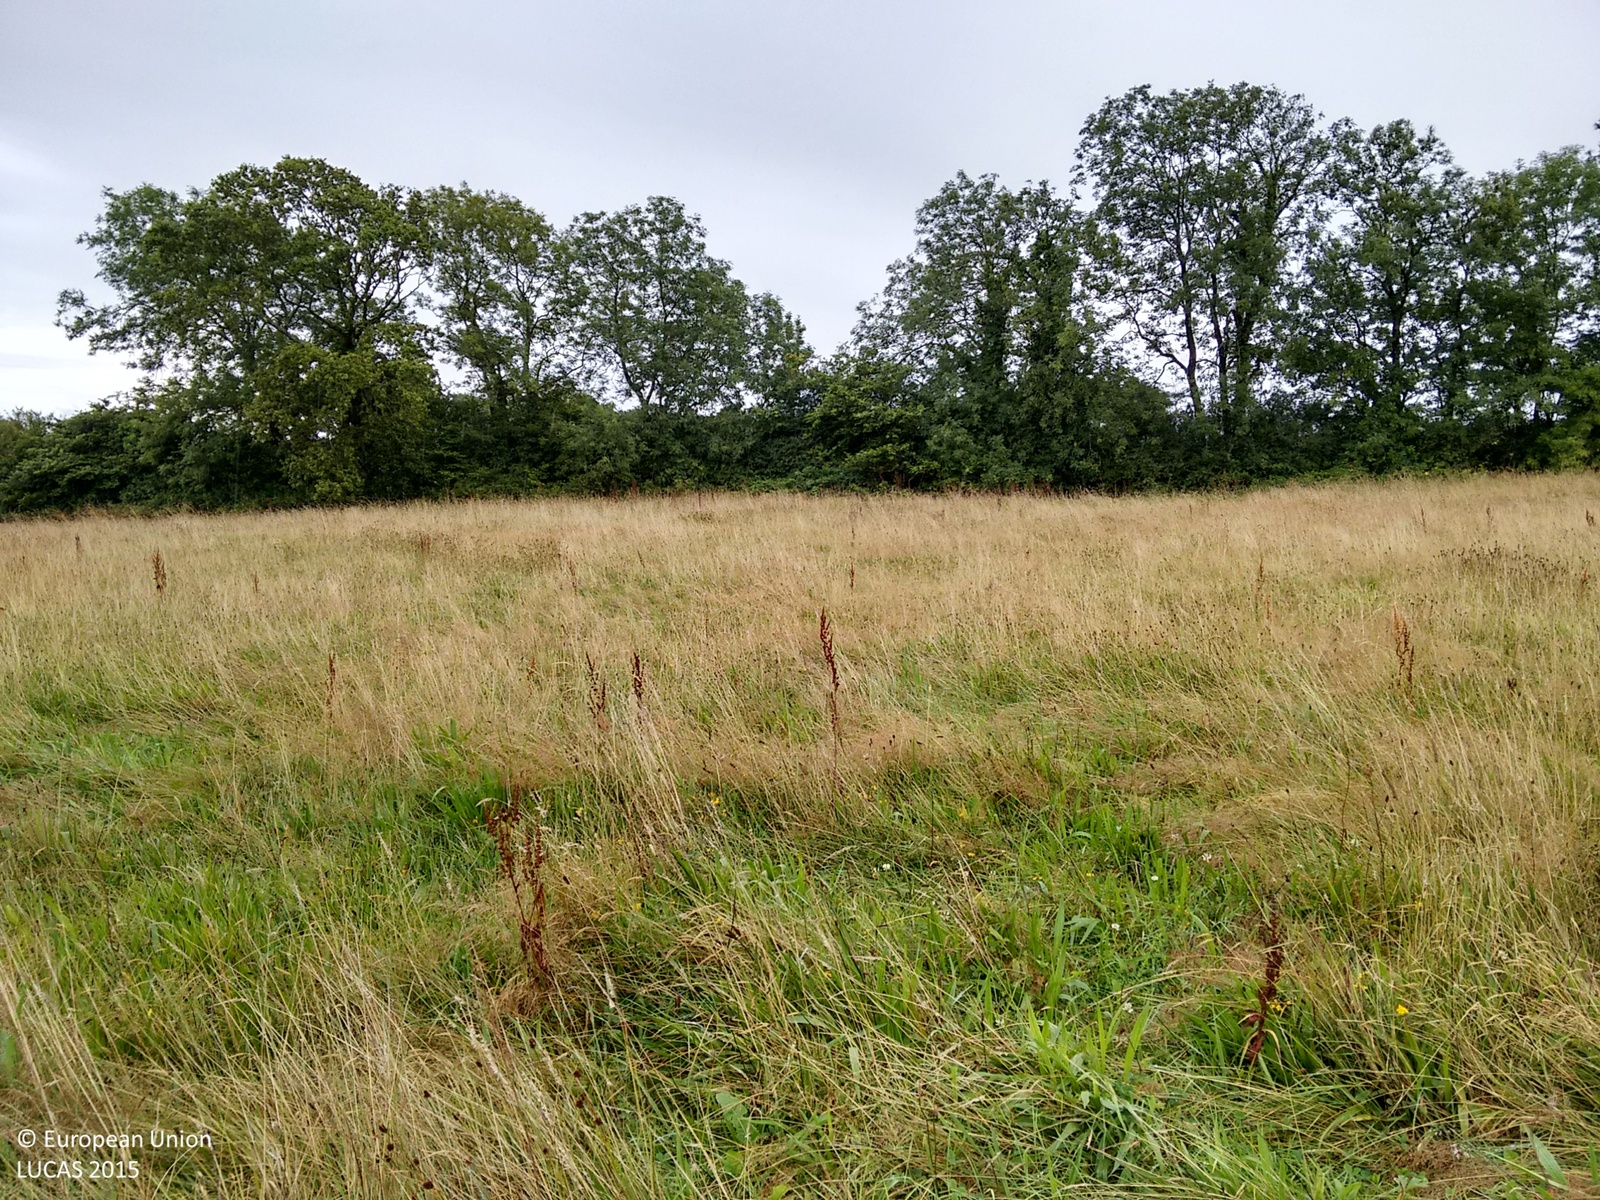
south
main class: Grassland
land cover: Grassland without tree/shrub cover
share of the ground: > 75 %
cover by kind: herbaceous plants 100 %
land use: Agriculture (excluding fallow land and kitchen gardens)
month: August
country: GB
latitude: 51.8218
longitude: -4.8391
